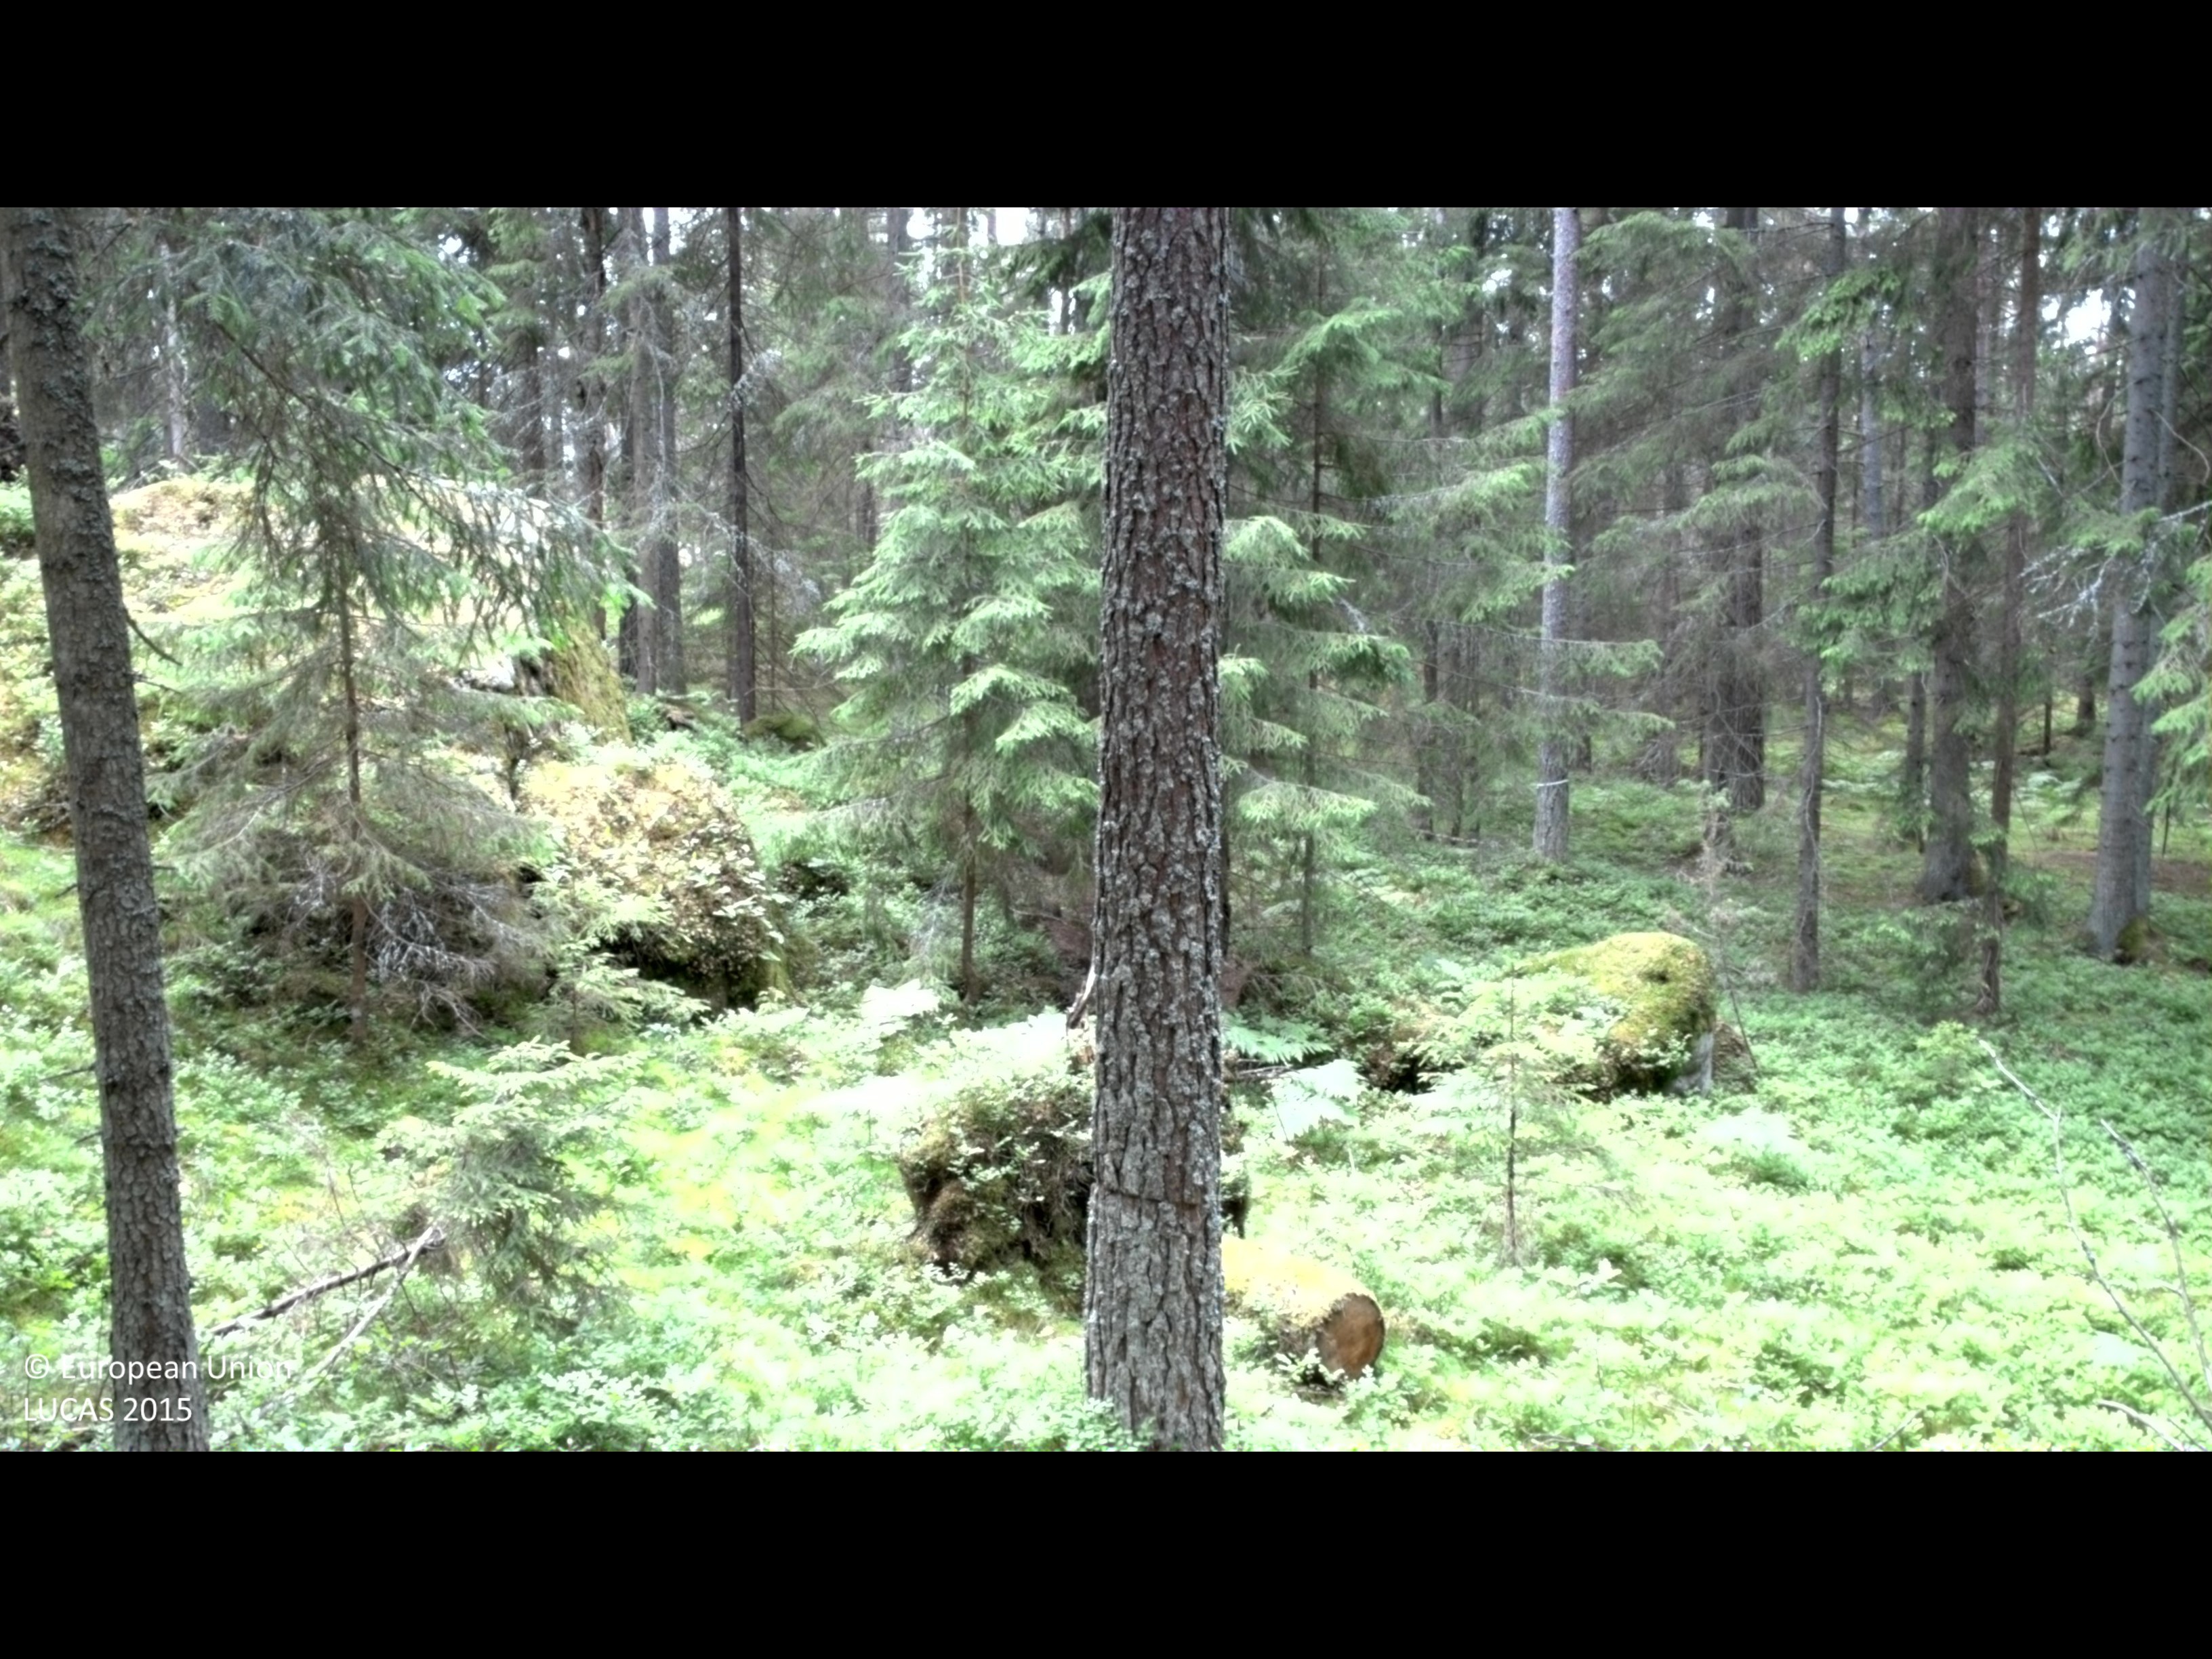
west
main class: Woodland
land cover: Spruce dominated coniferous woodland
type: boreal forest
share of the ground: 50 - 75 %
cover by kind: coniferous forest trees 65 %, shrubs 15 %, lichens and mosses 15 %, herbaceous plants 5 %
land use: Forestry
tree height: > 5 m
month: June
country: SE
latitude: 58.0741
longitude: 16.6270
